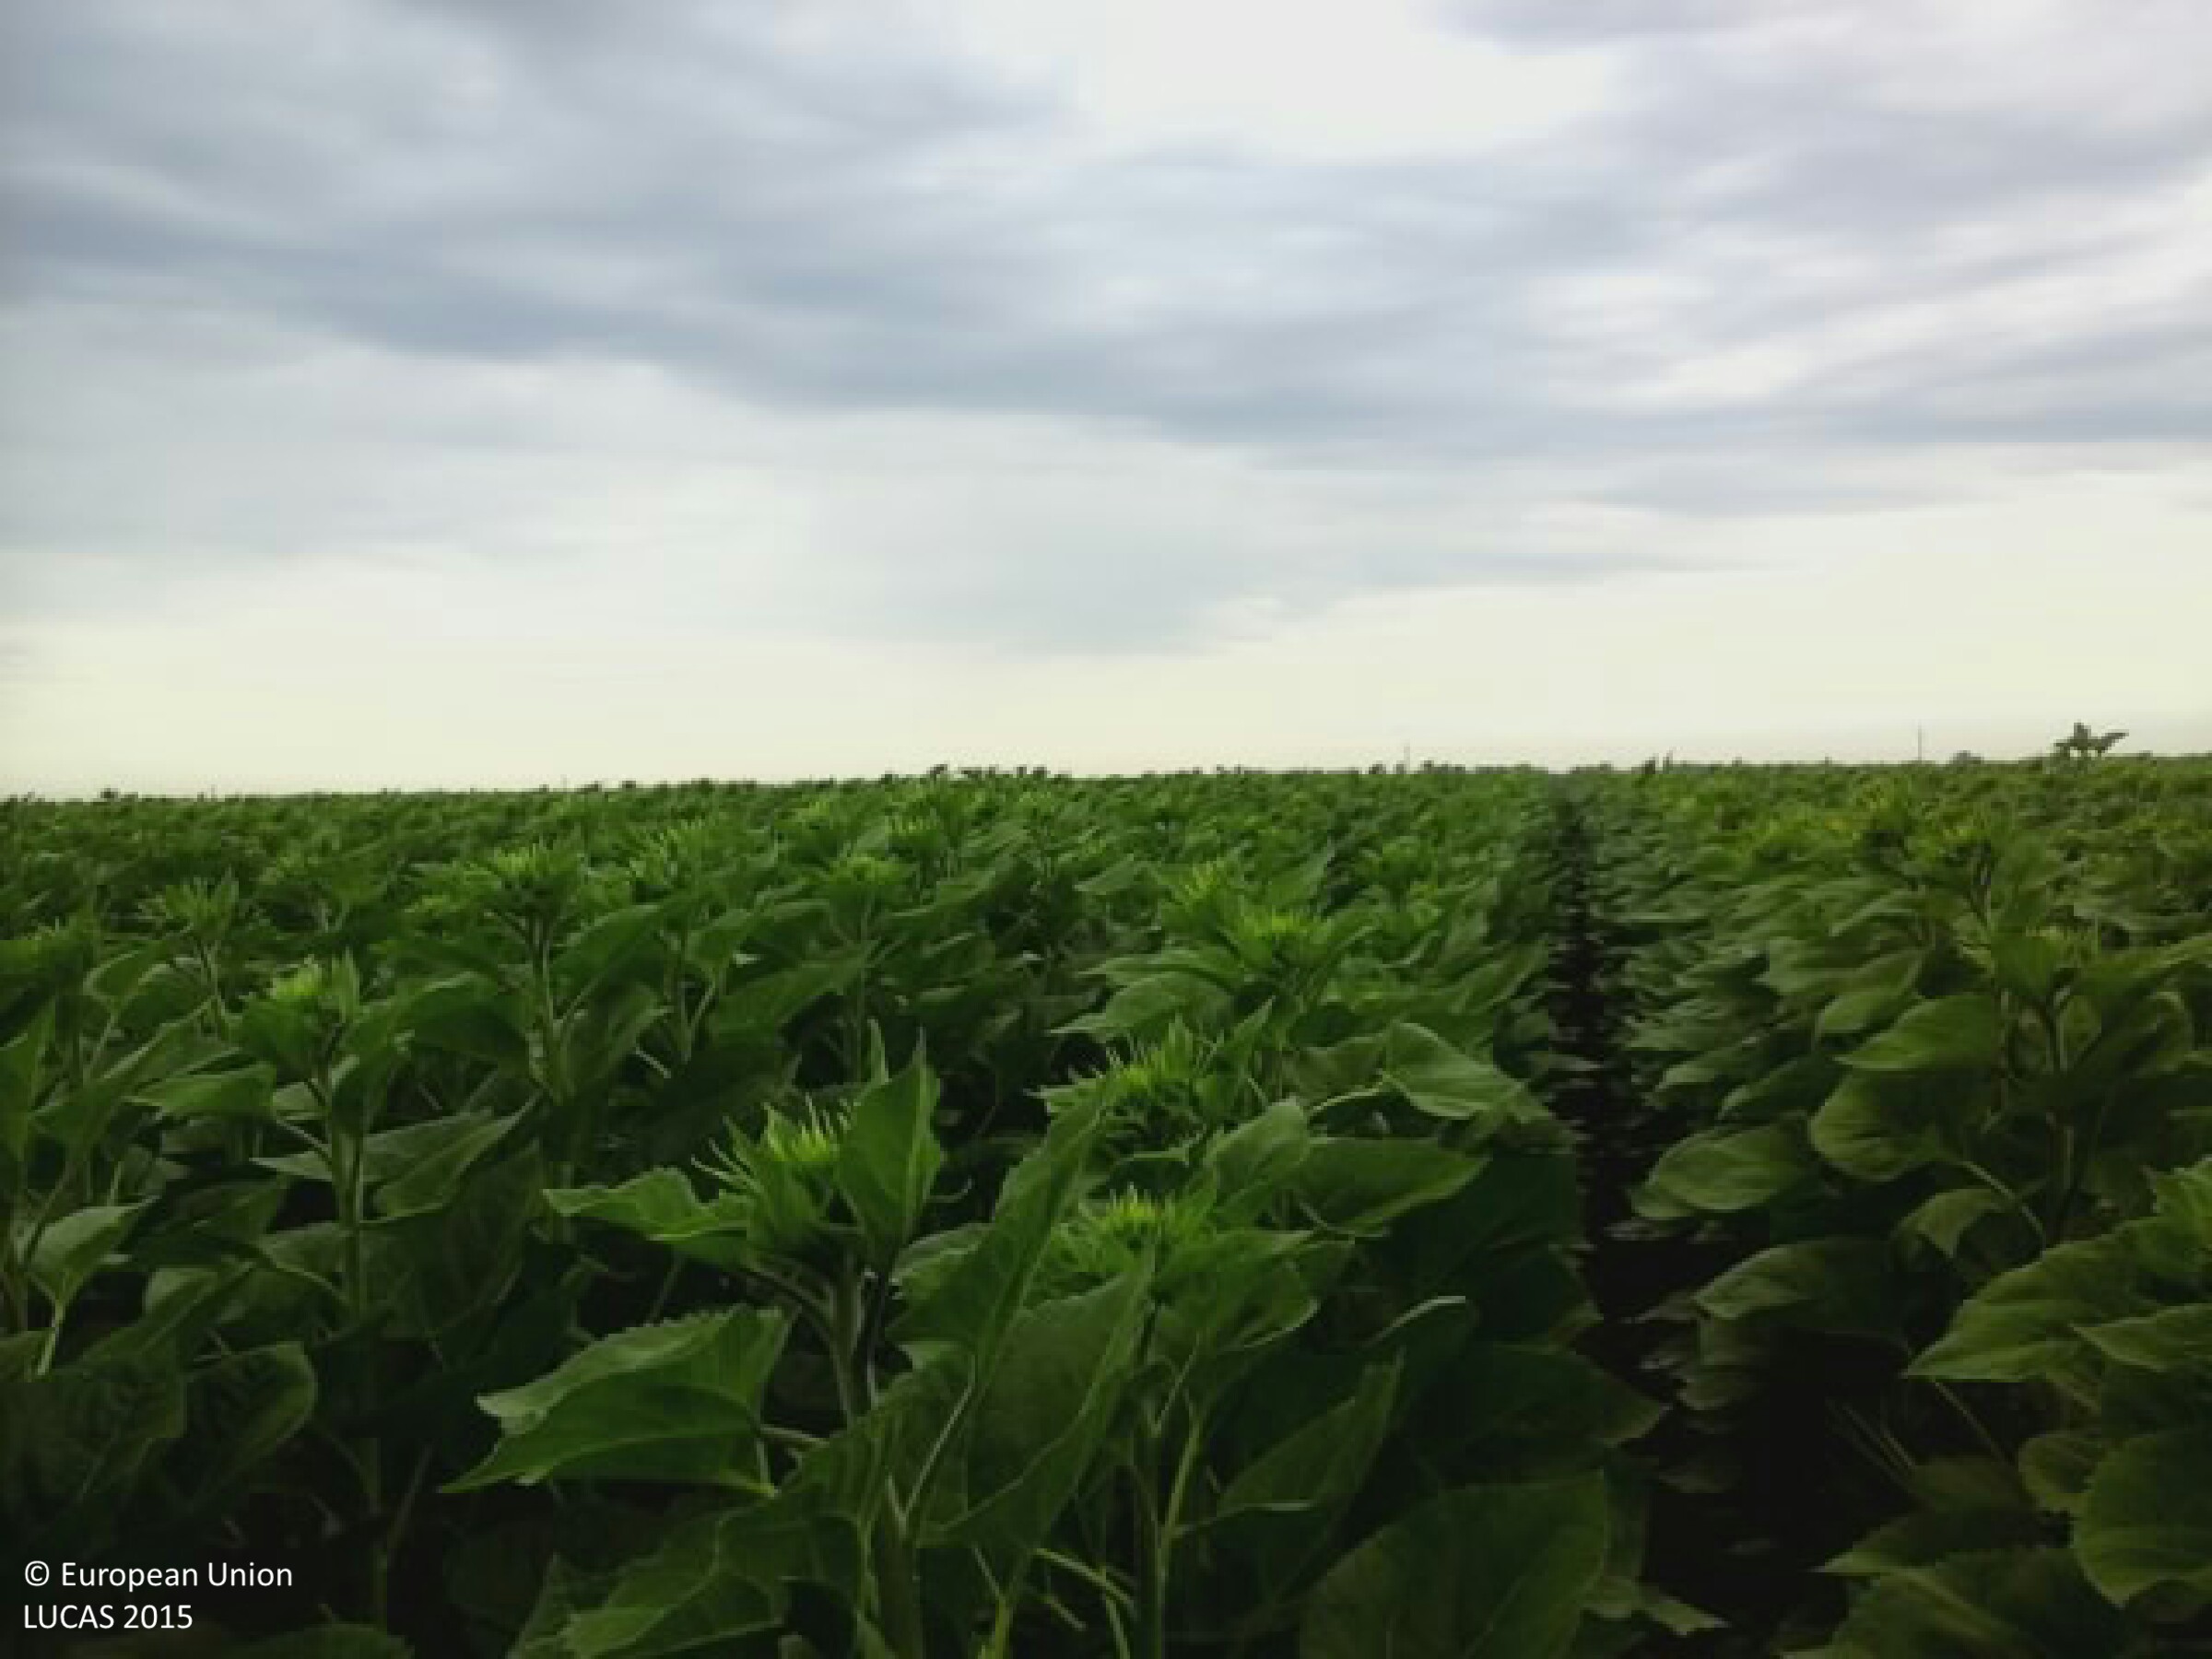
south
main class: Cropland
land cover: Sunflower
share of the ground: > 75 %
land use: Agriculture (excluding fallow land and kitchen gardens)
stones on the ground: < 10 %
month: June
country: HU
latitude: 46.3008
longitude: 18.9578
